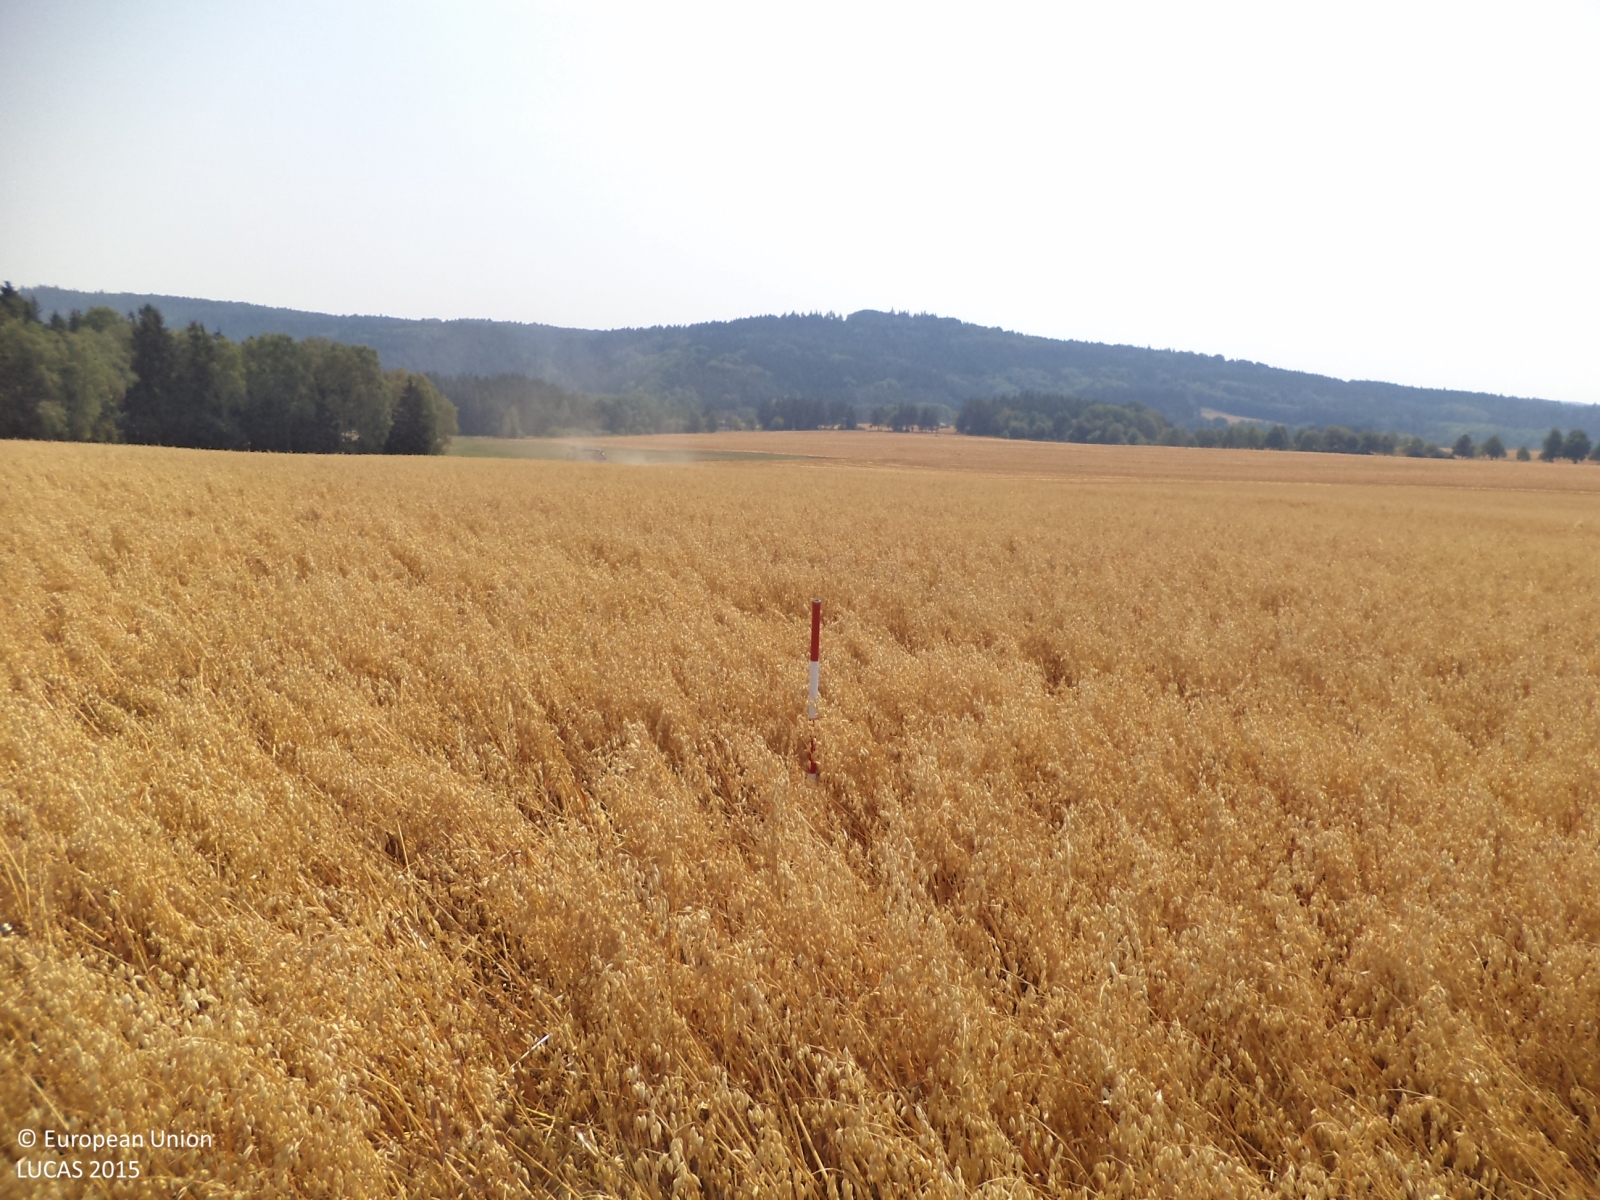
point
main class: Cropland
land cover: Oats
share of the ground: > 75 %
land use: Agriculture (excluding fallow land and kitchen gardens)
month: August
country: CZ
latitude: 49.4319
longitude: 14.4275
